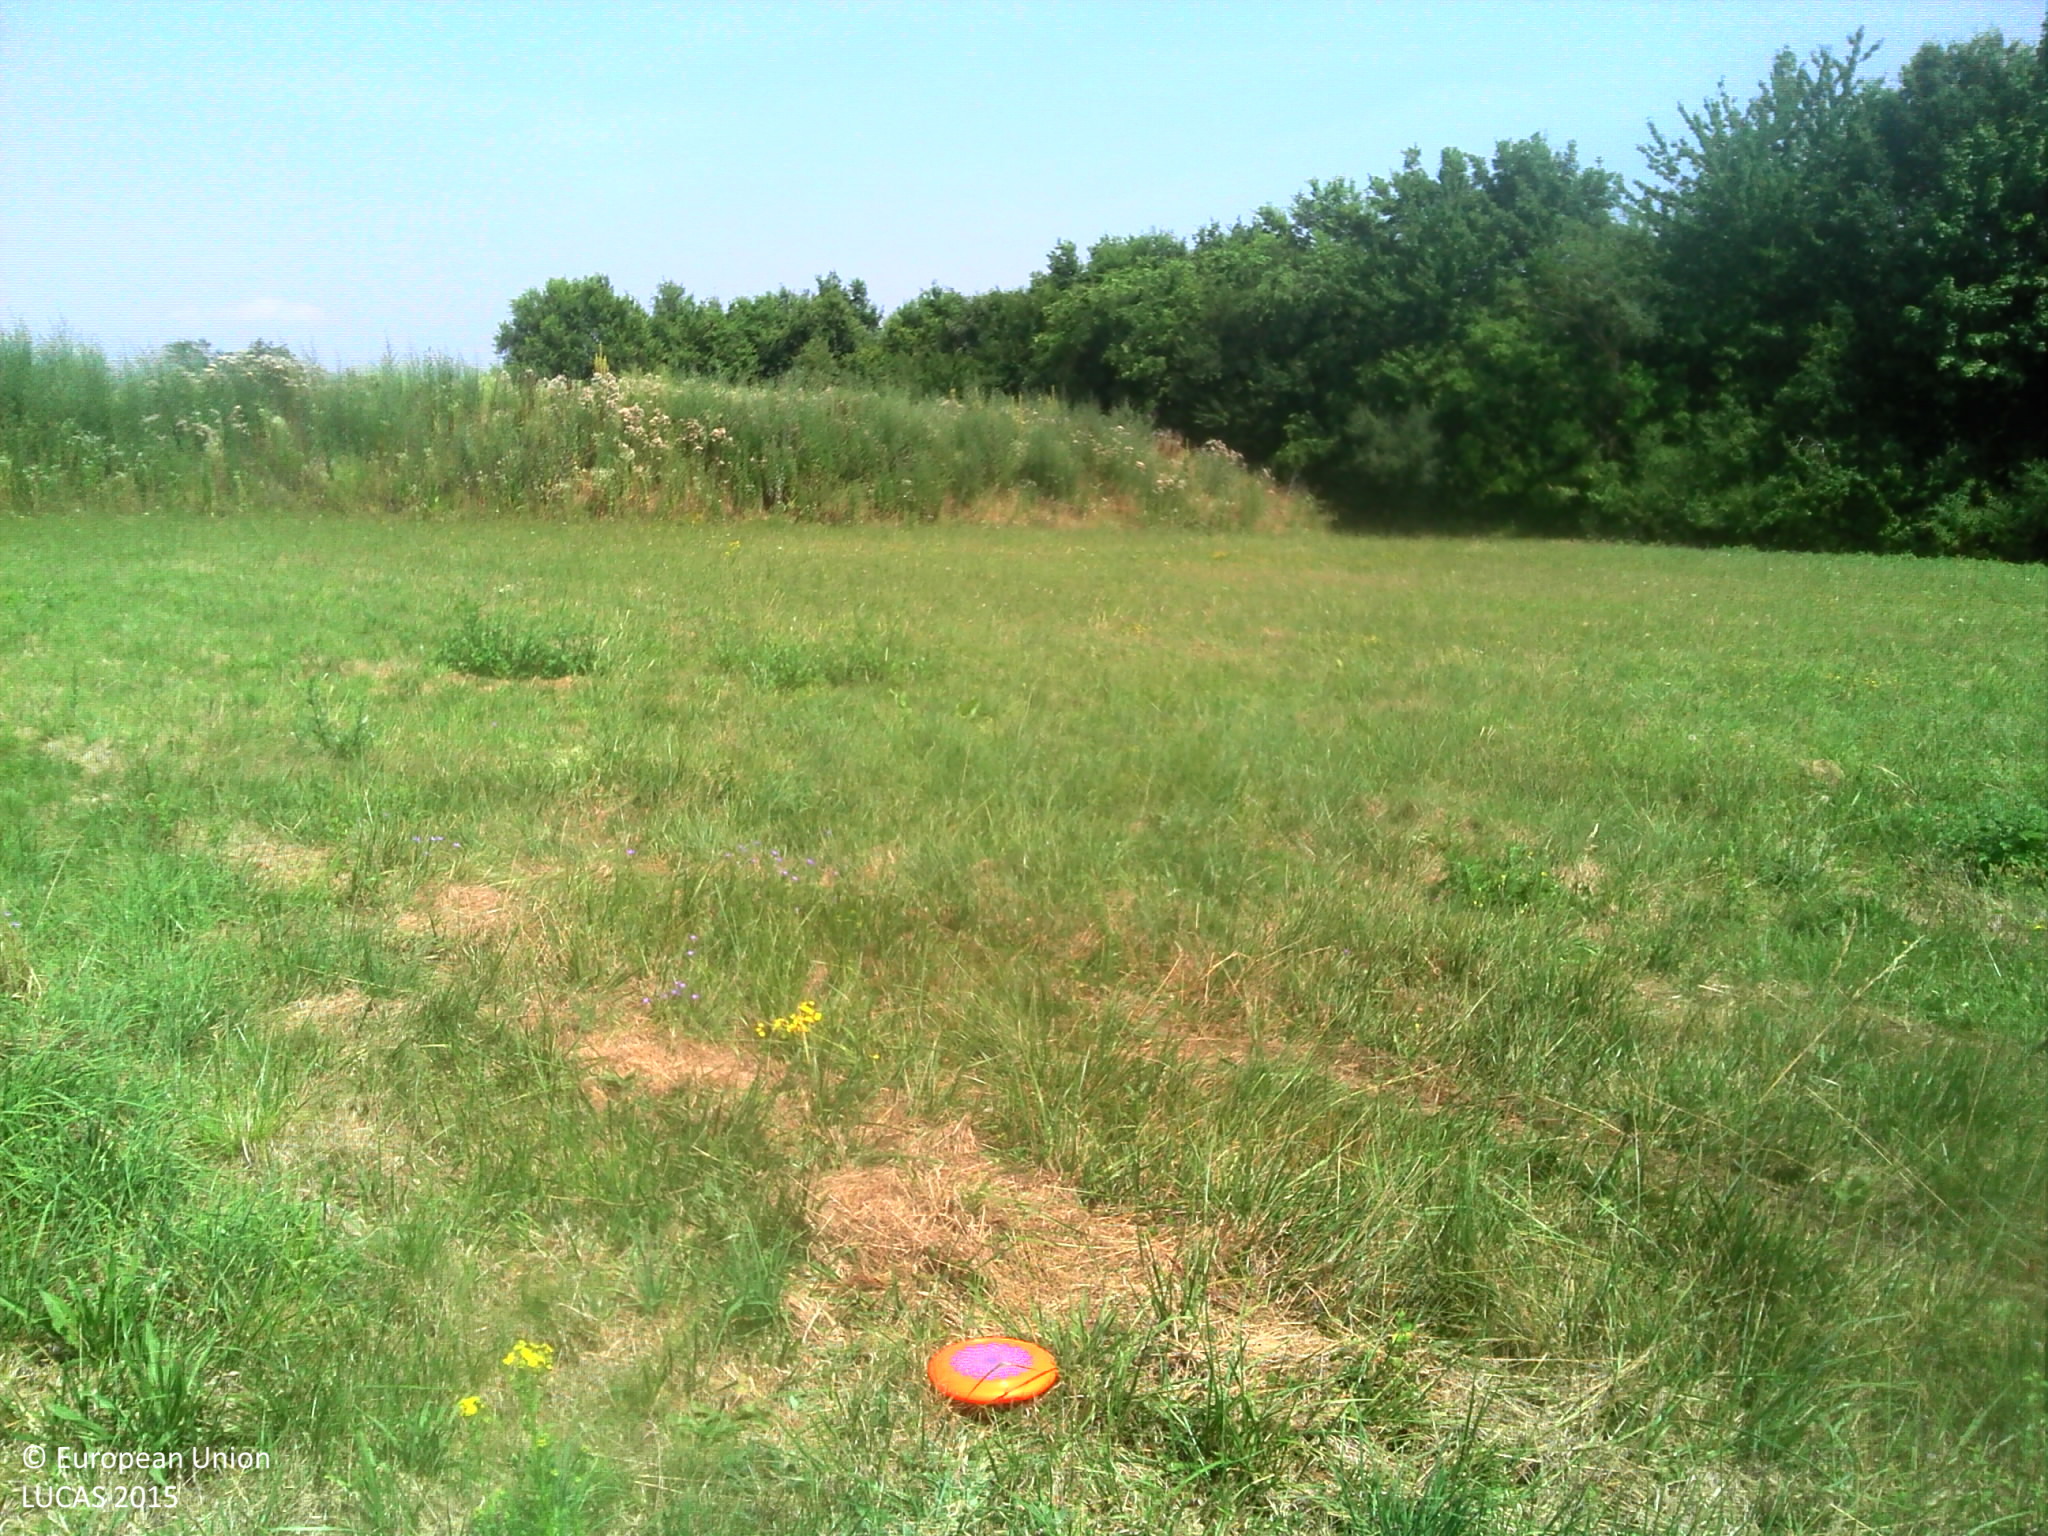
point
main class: Grassland
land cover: Grassland without tree/shrub cover
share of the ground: > 75 %
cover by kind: herbaceous plants 100 %
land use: Agriculture (excluding fallow land and kitchen gardens)
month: July
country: FR
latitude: 45.7543
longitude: 5.1573
